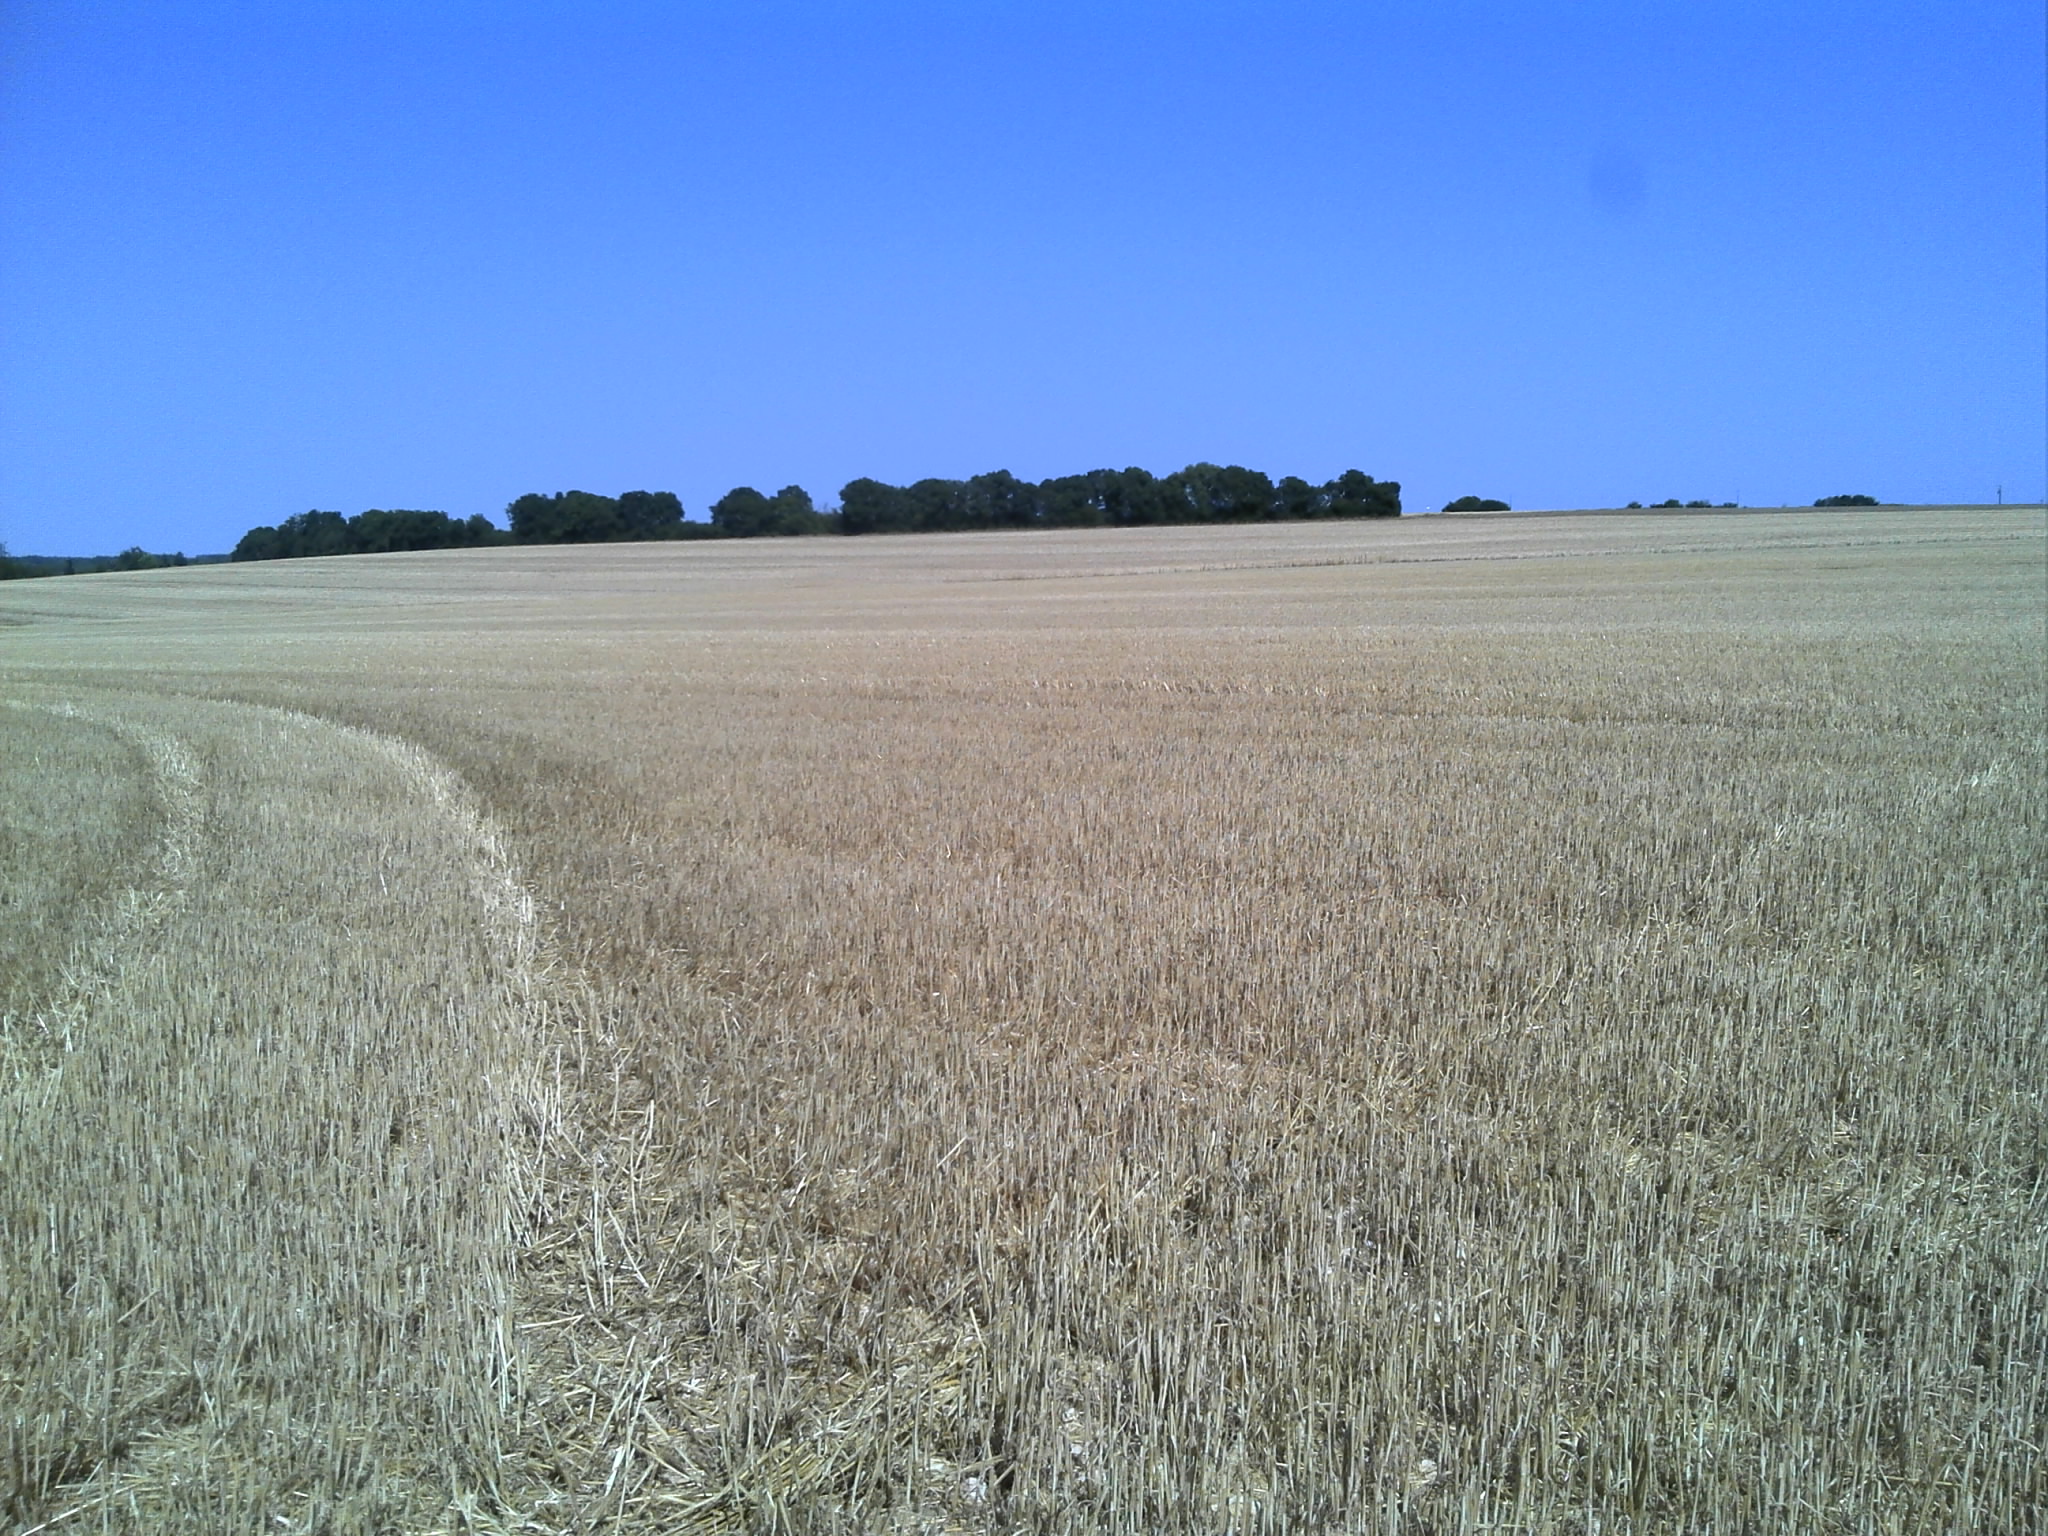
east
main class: Cropland
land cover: Durum wheat
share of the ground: > 75 %
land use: Agriculture (excluding fallow land and kitchen gardens)
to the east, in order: Durum wheat; Barley; Rape and turnip rape
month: July
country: FR
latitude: 46.8434
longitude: 1.4780
